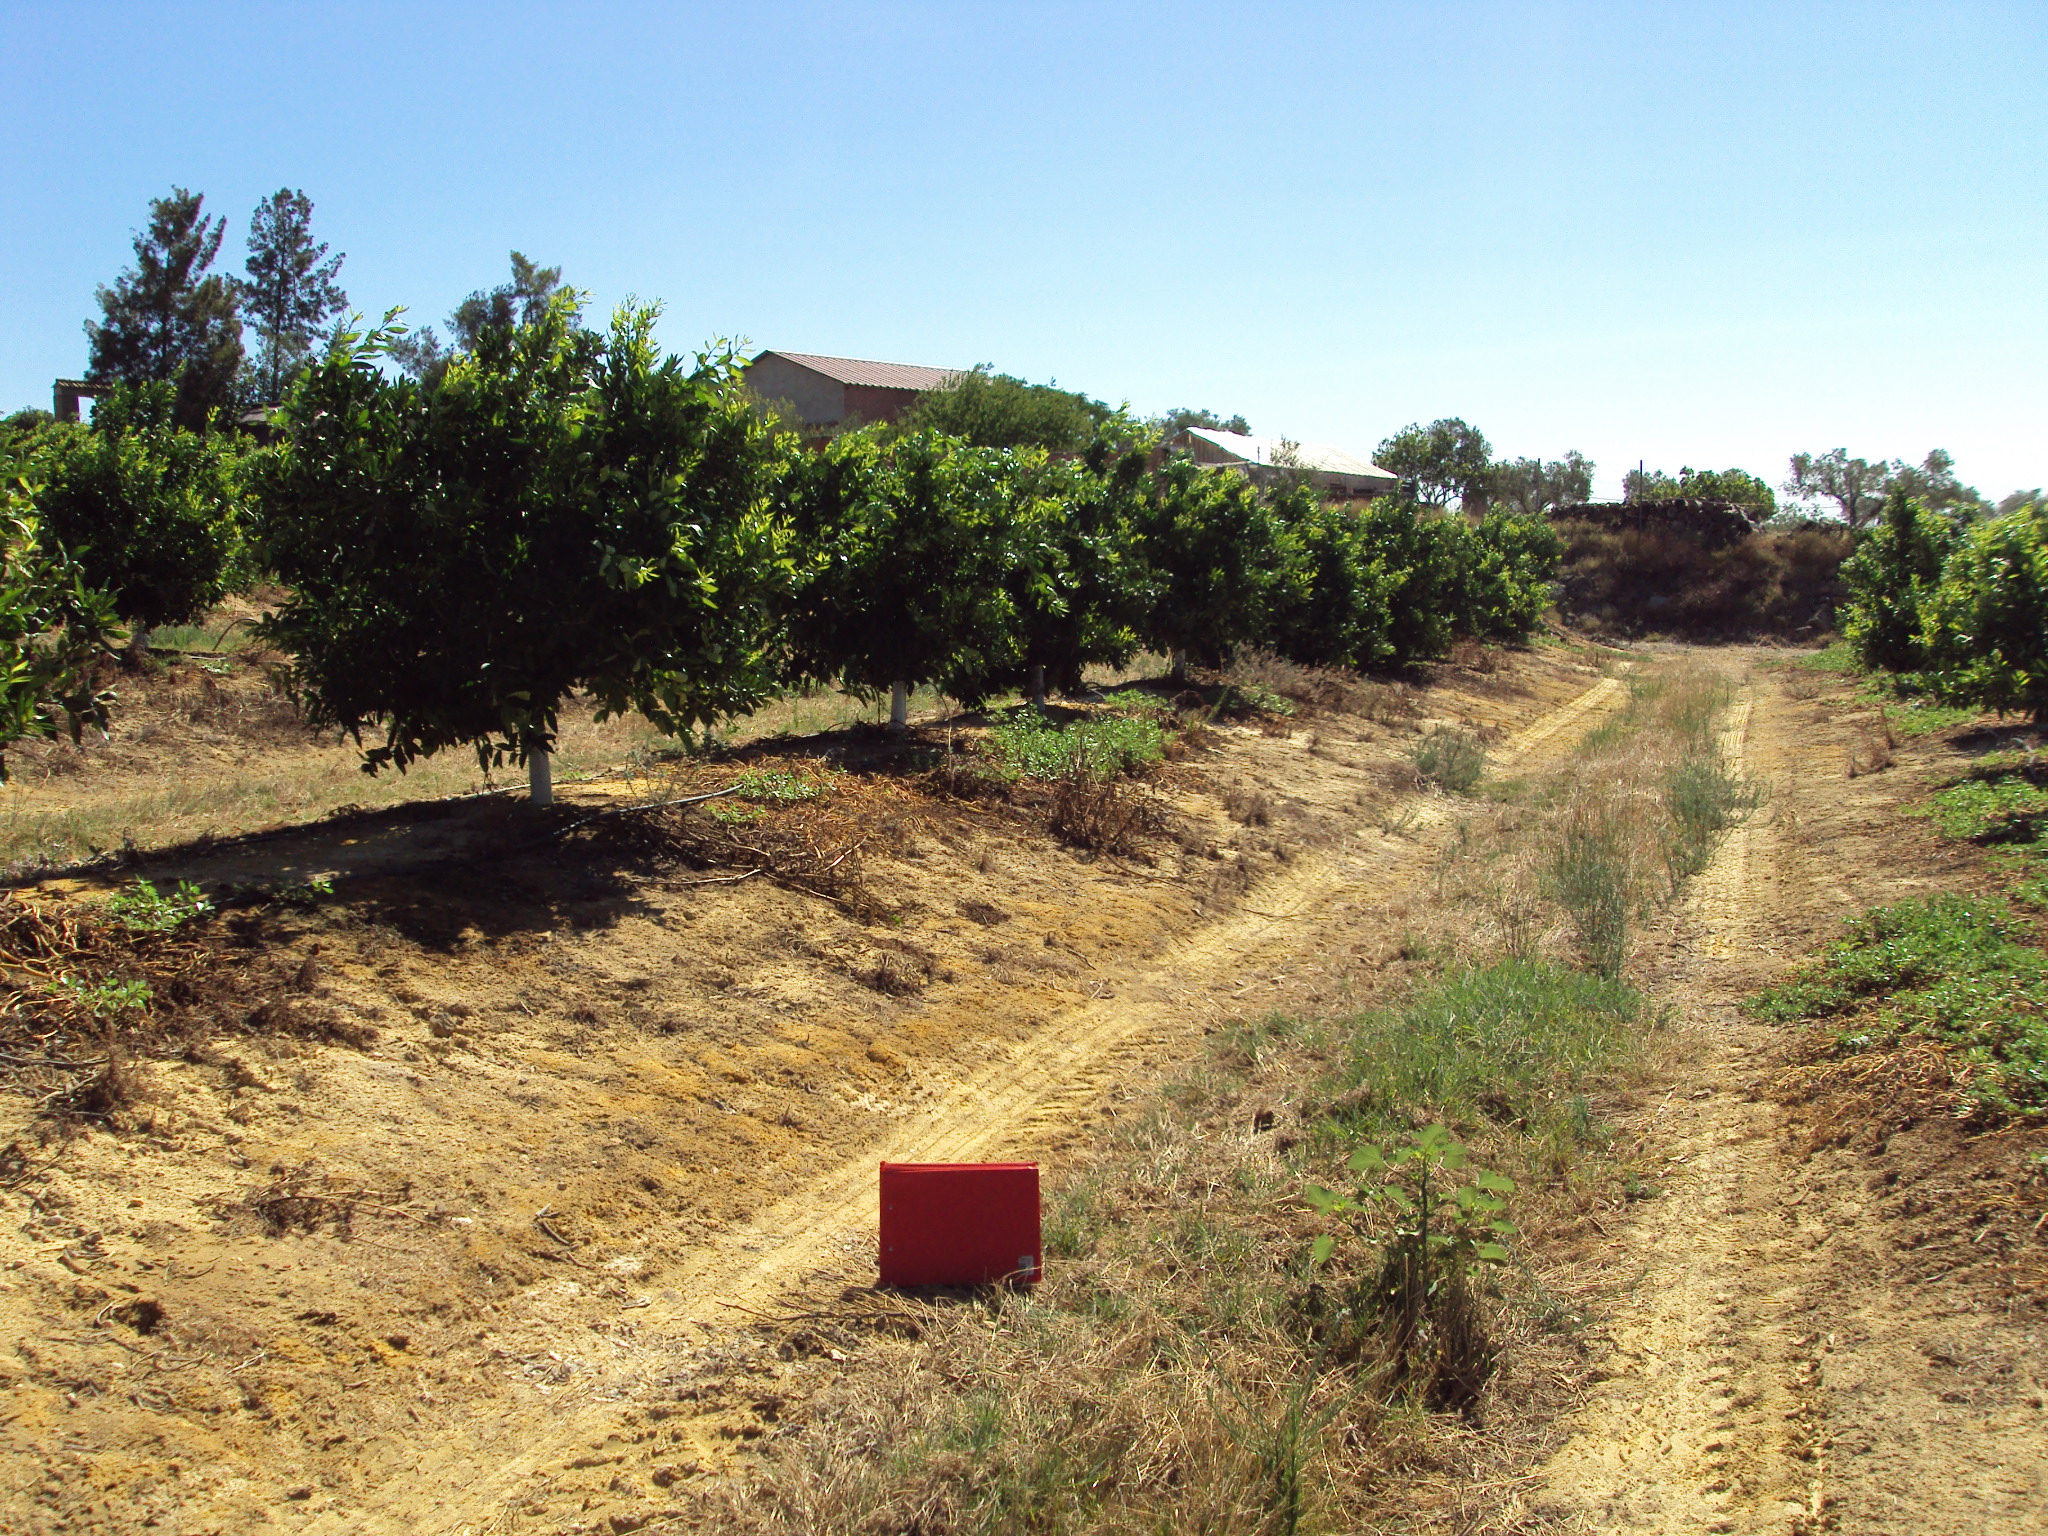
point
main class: Cropland
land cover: Oranges
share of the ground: 50 - 75 %
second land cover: Spontaneously vegetated surfaces
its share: > 75 %
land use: Agriculture (excluding fallow land and kitchen gardens)
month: July
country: ES
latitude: 37.4249
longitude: -7.0966
